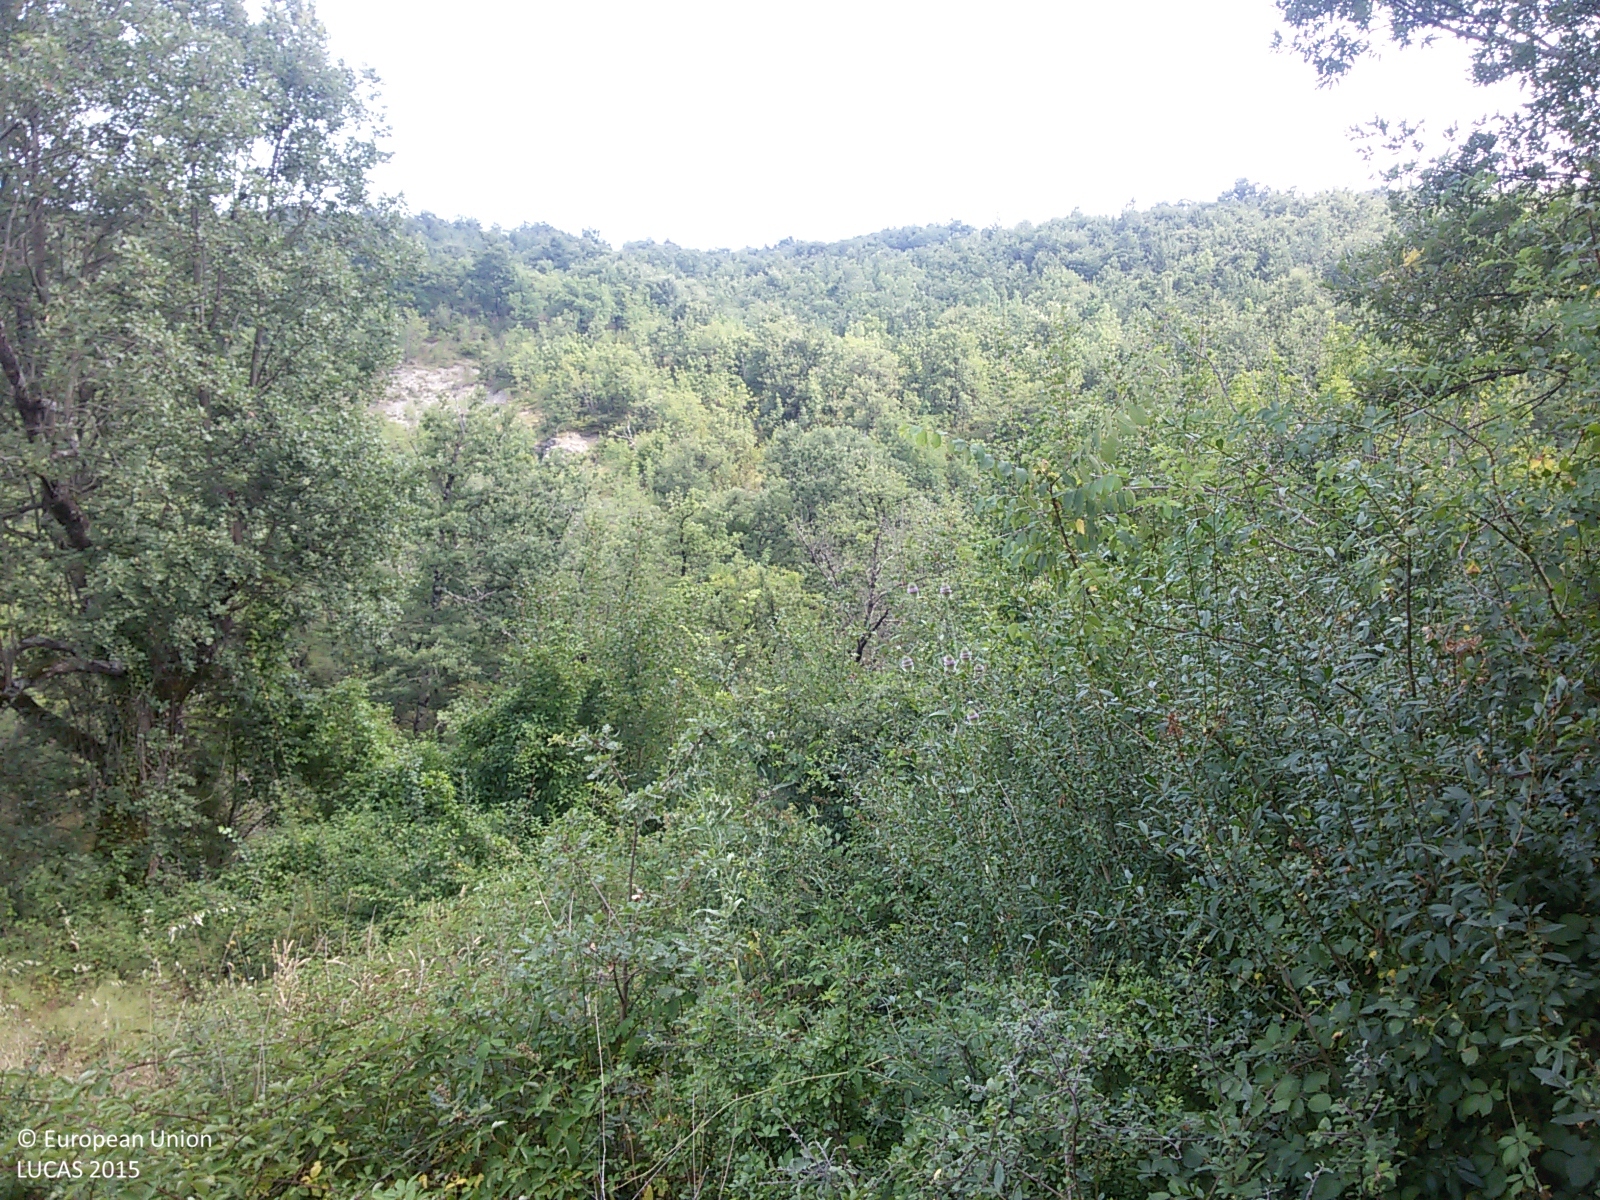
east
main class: Woodland
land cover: Broadleaved woodland
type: thermophilous deciduous forest
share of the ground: > 75 %
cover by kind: broadleaved forest trees 50 %, shrubs 30 %, herbaceous plants 10 %, consolidated bare surface 10 %
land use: Forestry
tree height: < 5 m
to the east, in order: Broadleaved woodland; Rivers and streams; Broadleaved woodland; Rivers and streams; Broadleaved woodland
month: July
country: IT
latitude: 42.7878
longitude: 11.4744
